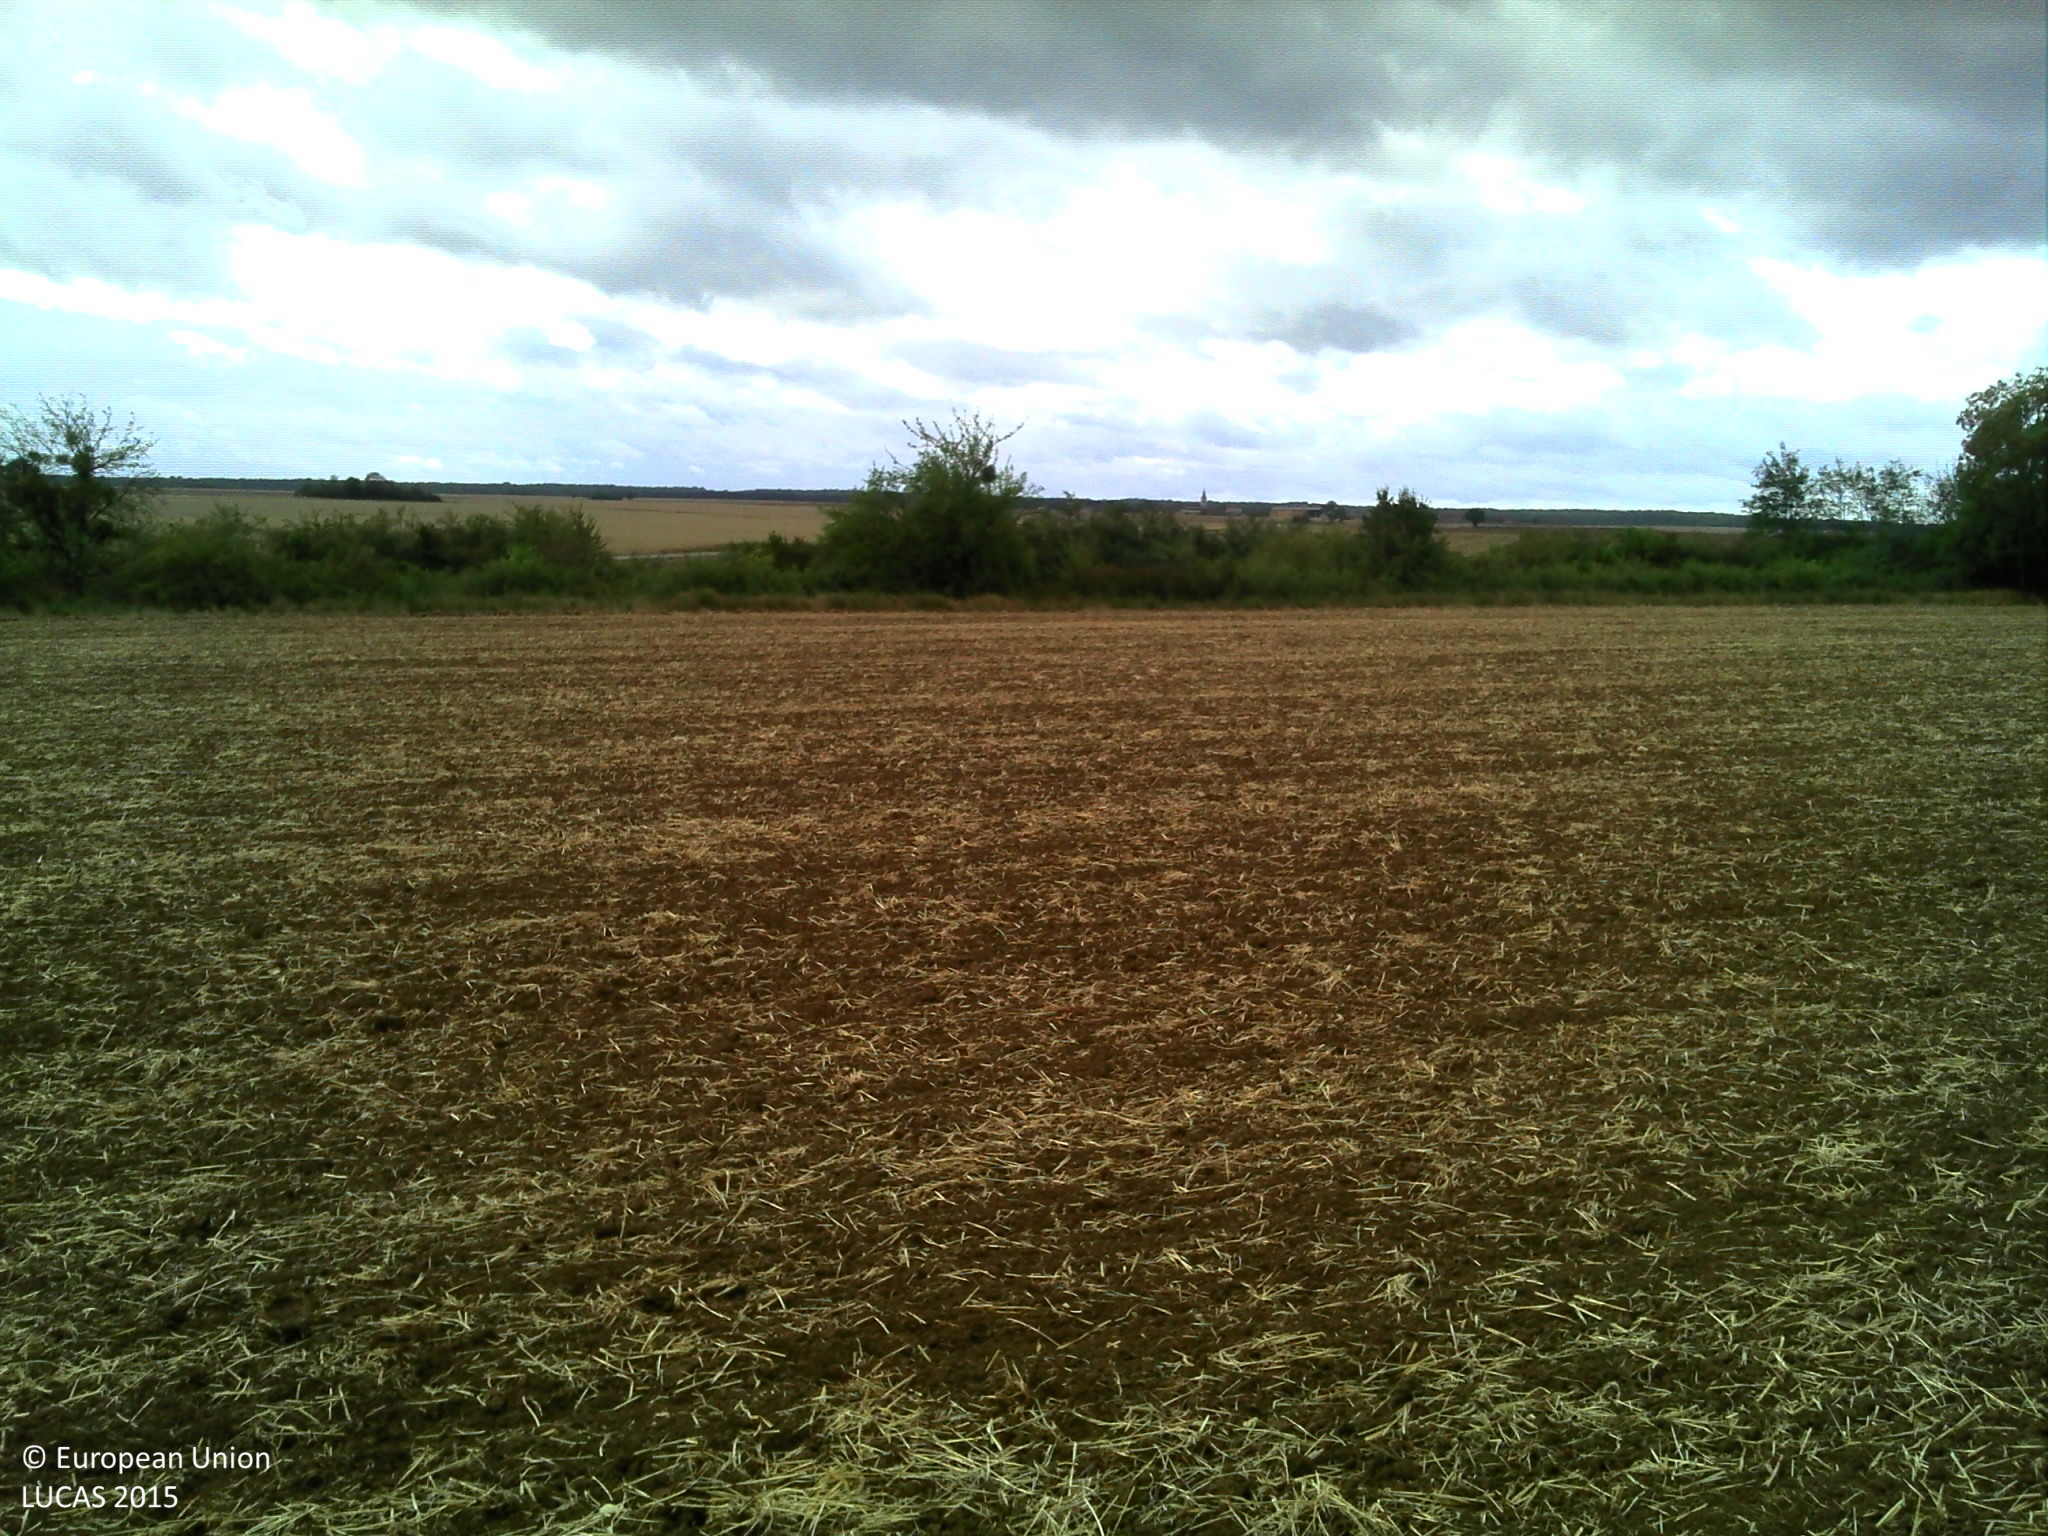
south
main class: Cropland
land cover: Barley
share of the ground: < 10 %
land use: Agriculture (excluding fallow land and kitchen gardens)
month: August
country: FR
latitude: 47.9190
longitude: 4.7666
